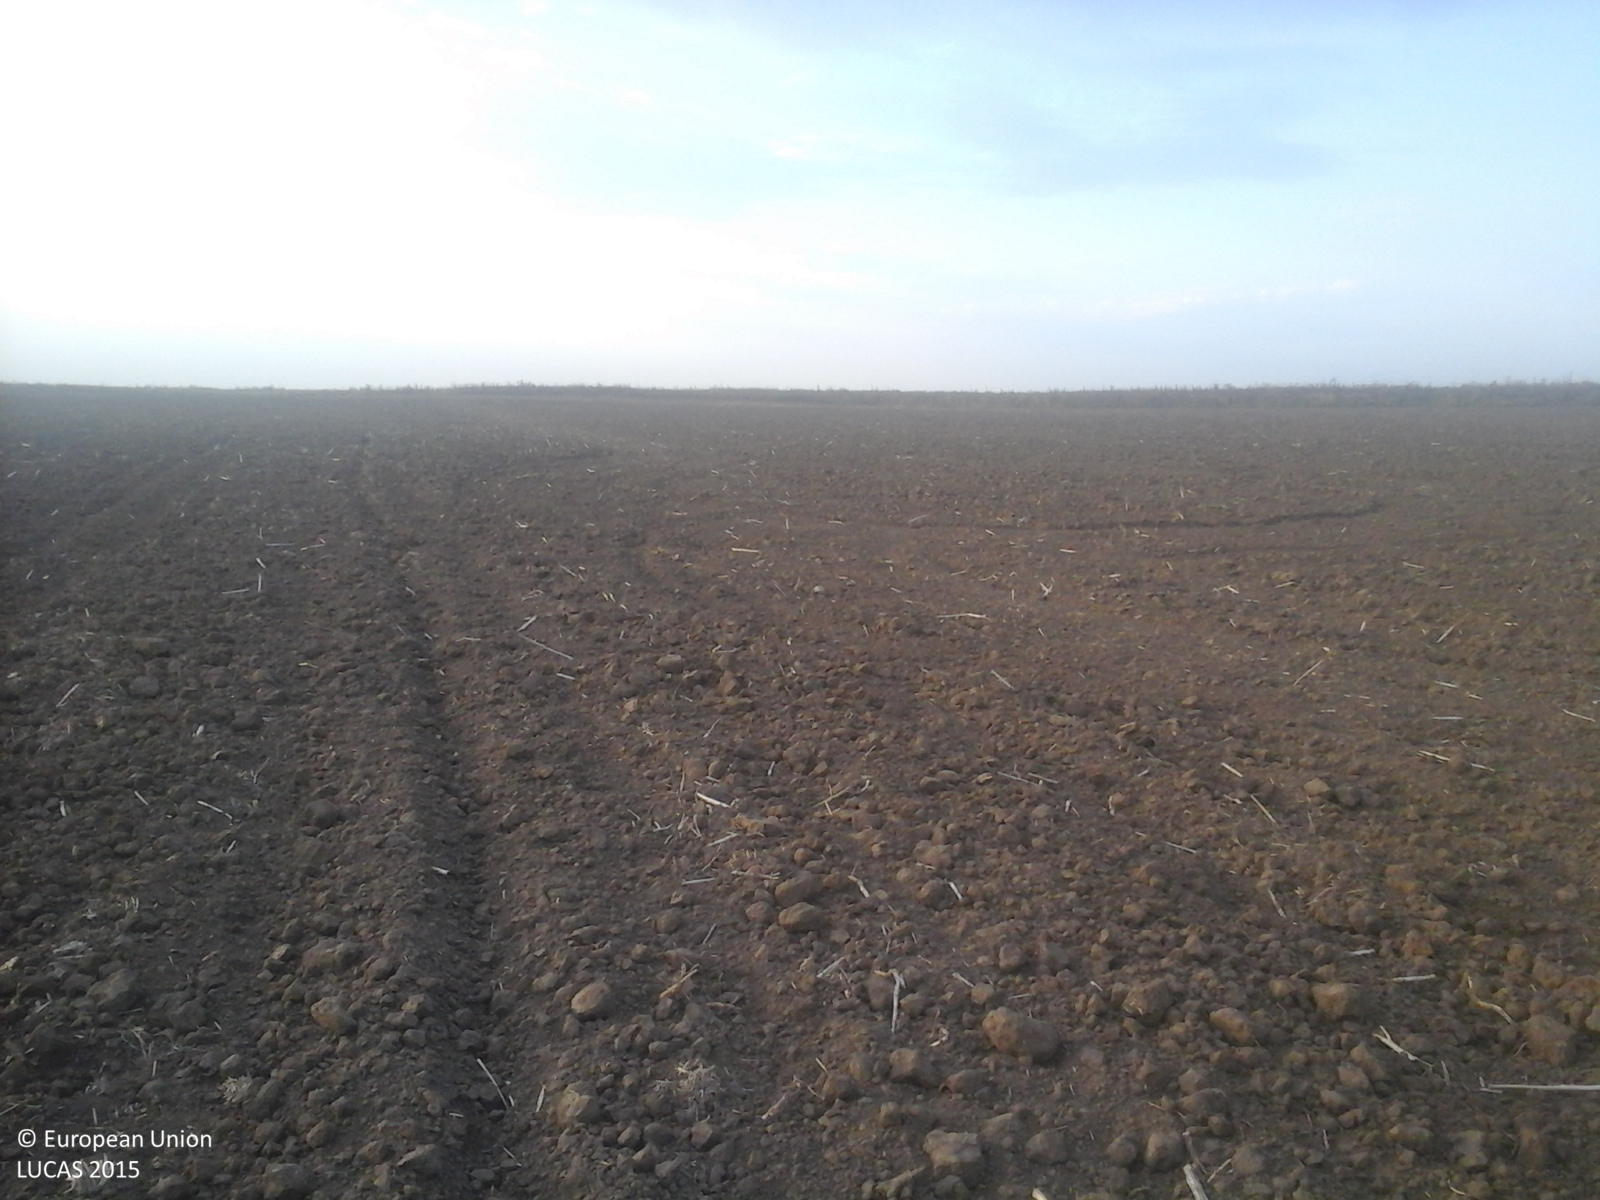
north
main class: Cropland
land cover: Rape and turnip rape
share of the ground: < 10 %
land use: Agriculture (excluding fallow land and kitchen gardens)
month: August
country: RO
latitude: 44.1235
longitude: 28.1149
